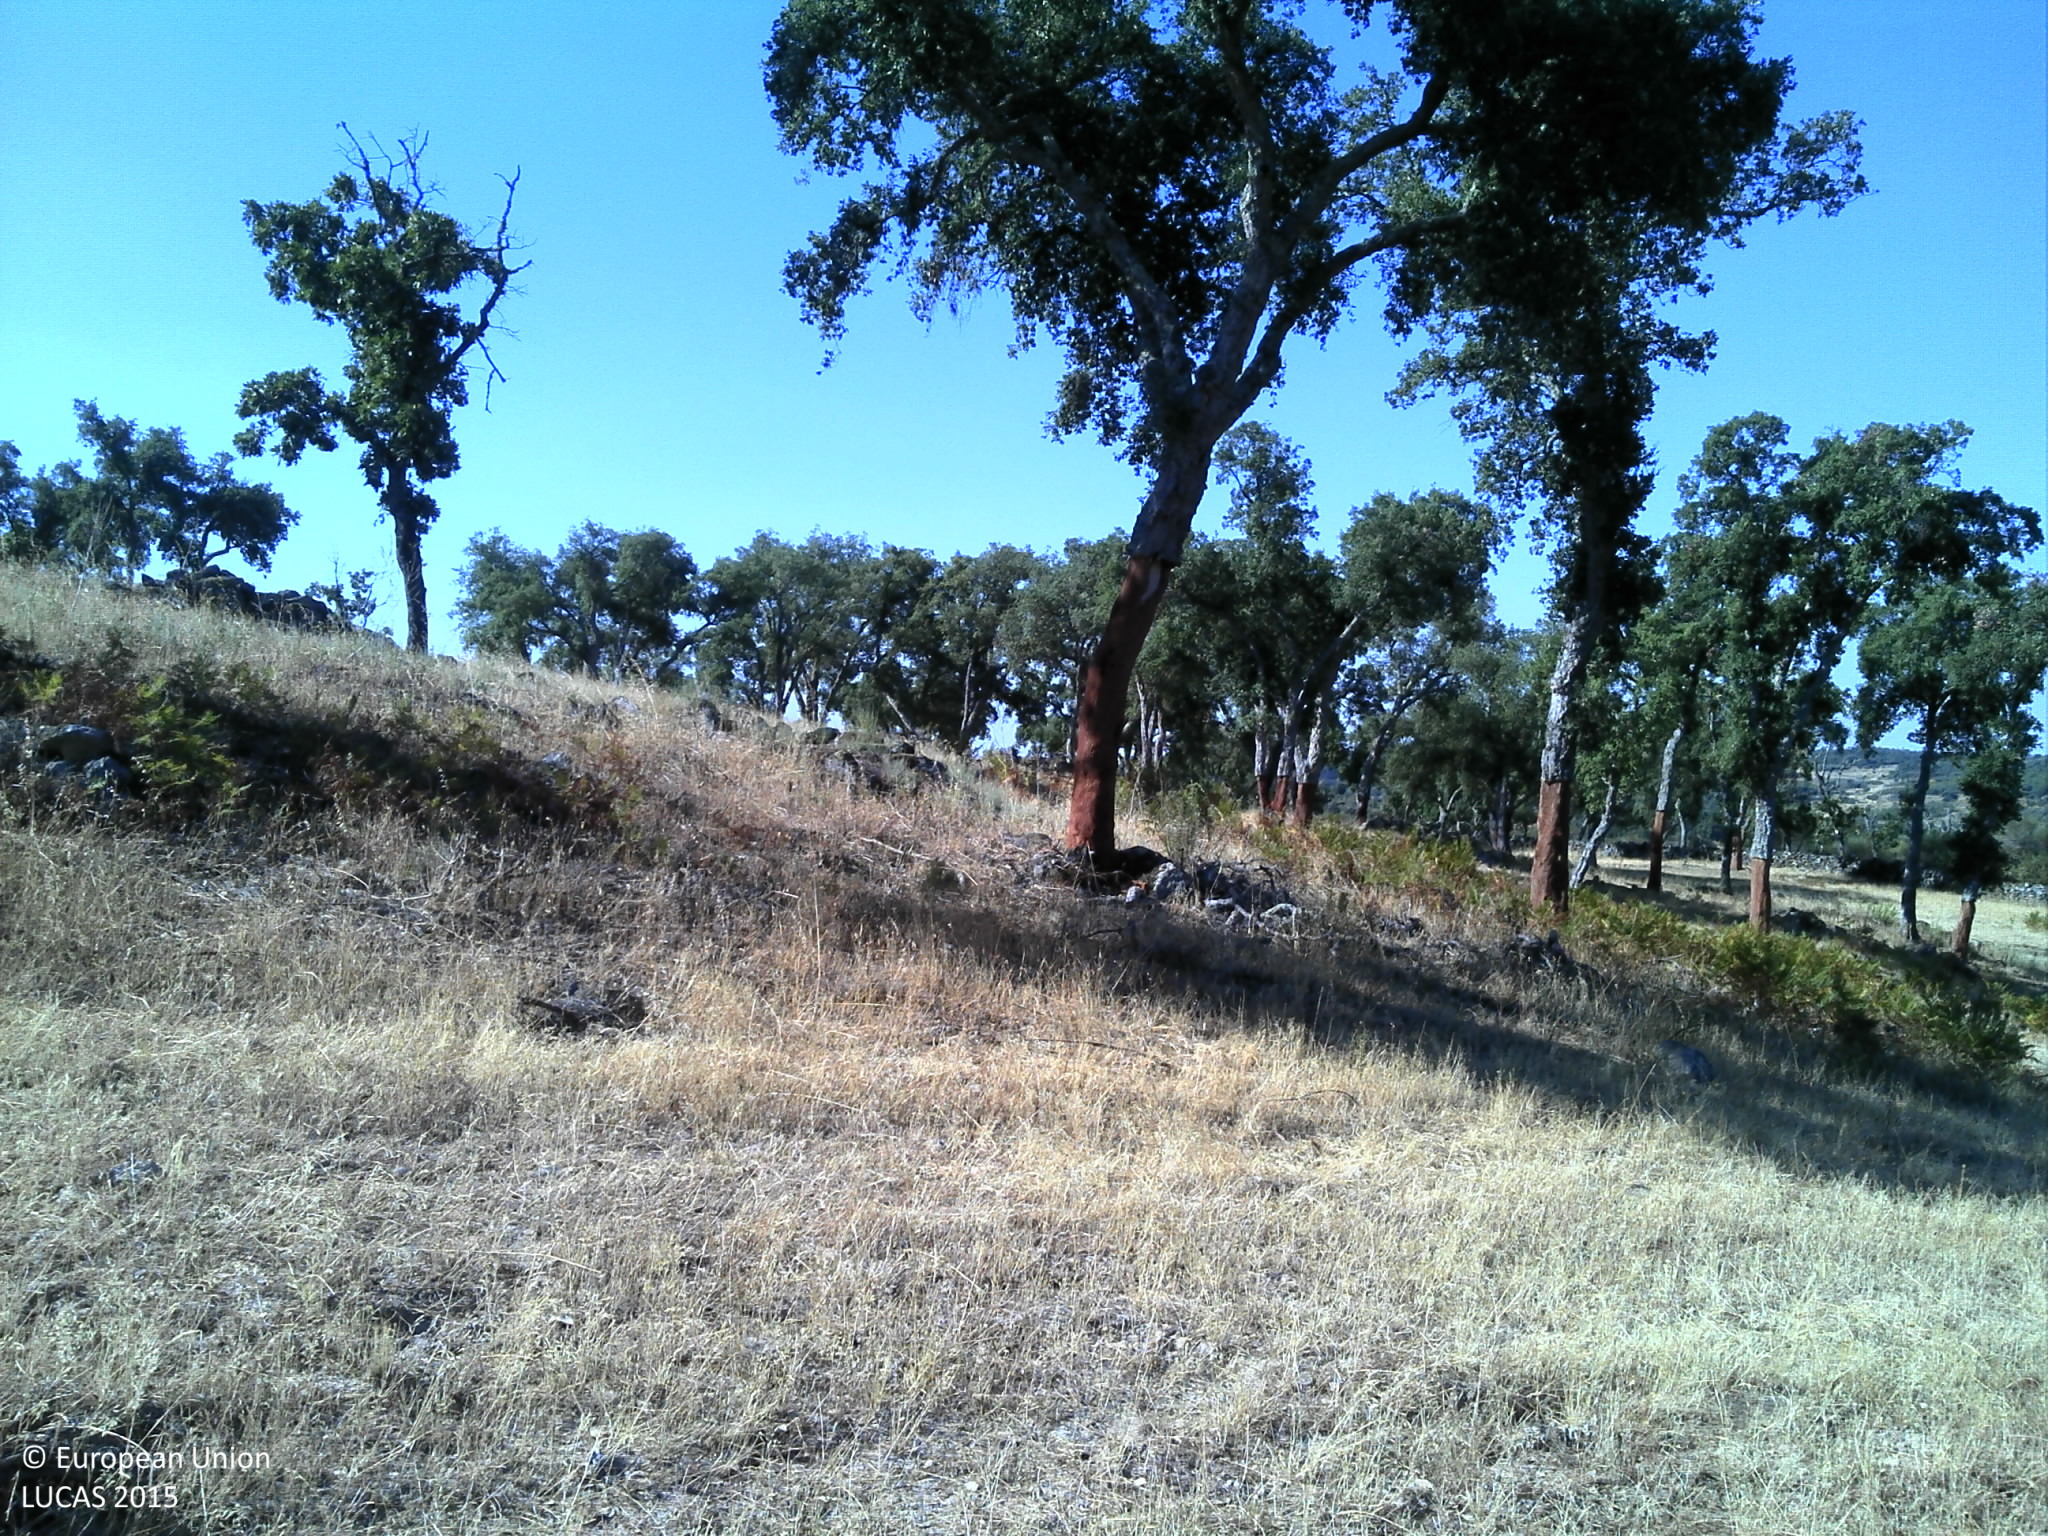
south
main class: Woodland
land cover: Broadleaved woodland
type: broadleaved evergreen forest
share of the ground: 10 - 25 %
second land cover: Grassland without tree/shrub cover
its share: 50 - 75 %
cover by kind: herbaceous plants 60 %, broadleaved forest trees 15 %, unconsolidated bare surface 15 %, consolidated bare surface 10 %
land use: Forestry
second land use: Agriculture (excluding fallow land and kitchen gardens)
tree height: > 5 m
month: August
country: PT
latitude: 39.3833
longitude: -7.4937
